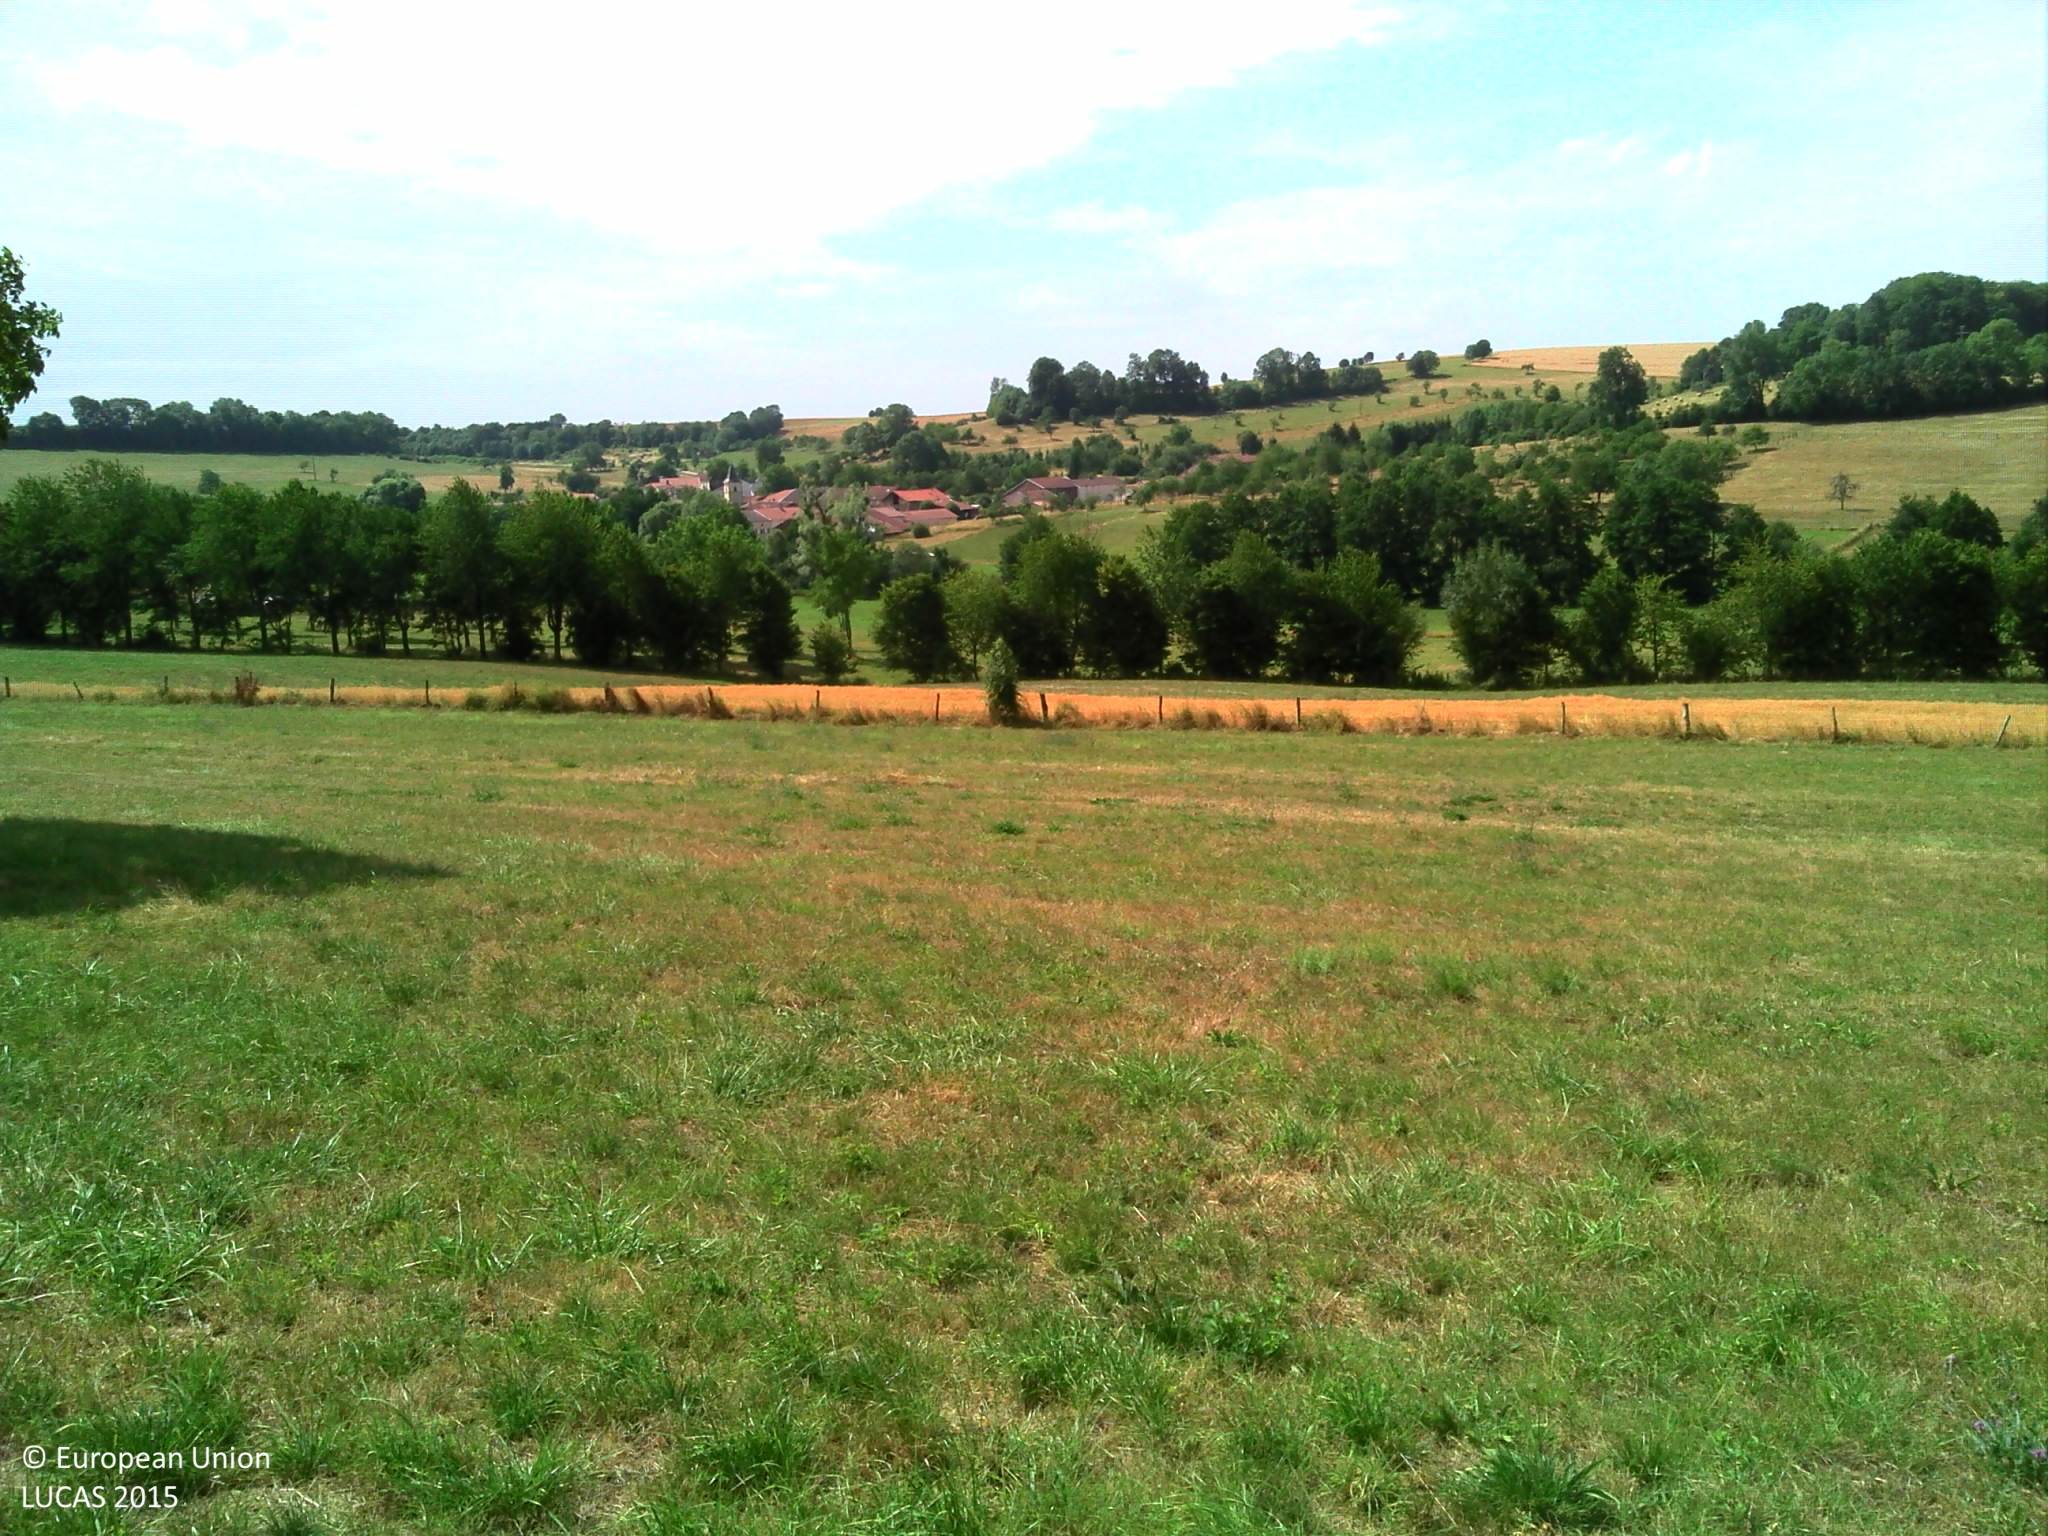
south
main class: Grassland
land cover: Grassland with sparse tree/shrub cover
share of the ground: > 75 %
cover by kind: herbaceous plants 95 %, broadleaved forest trees 5 %
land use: Agriculture (excluding fallow land and kitchen gardens)
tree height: > 5 m
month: July
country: FR
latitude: 48.4018
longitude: 5.9613
